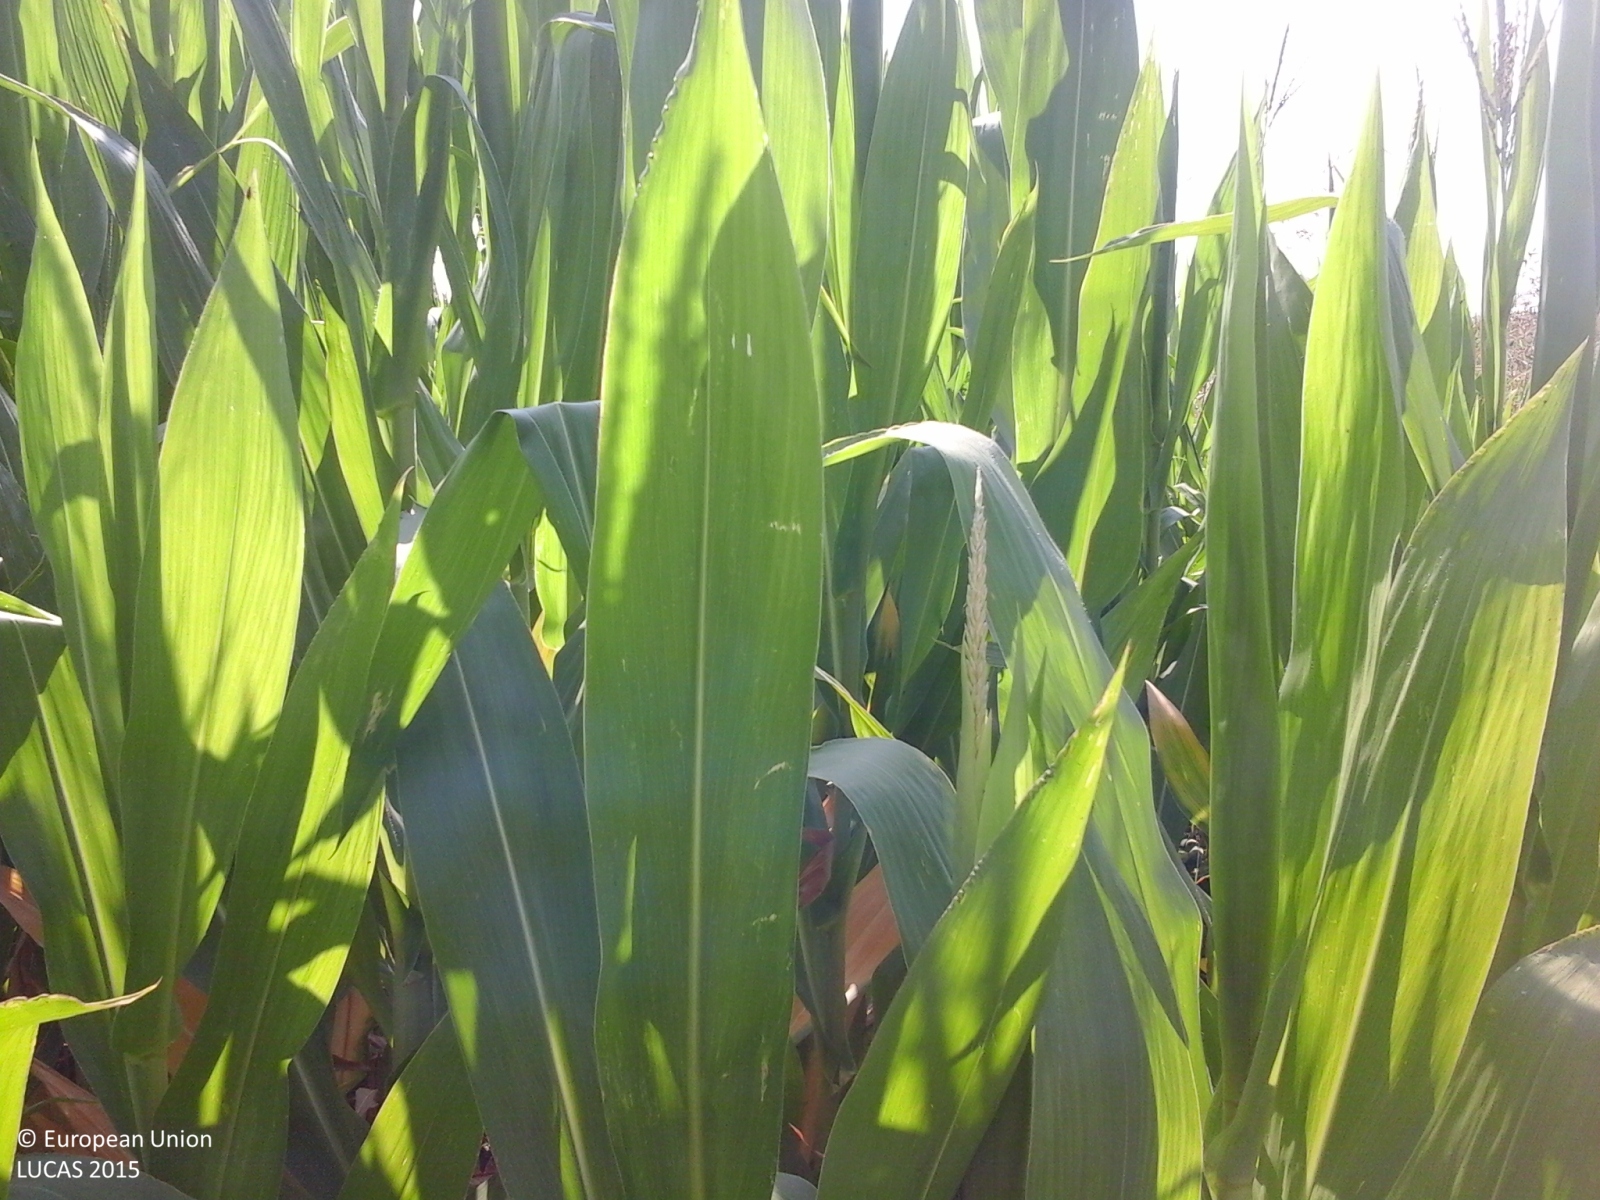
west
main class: Cropland
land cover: Maize
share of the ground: > 75 %
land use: Agriculture (excluding fallow land and kitchen gardens)
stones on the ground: < 10 %
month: July
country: IT
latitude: 45.3207
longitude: 10.8532
